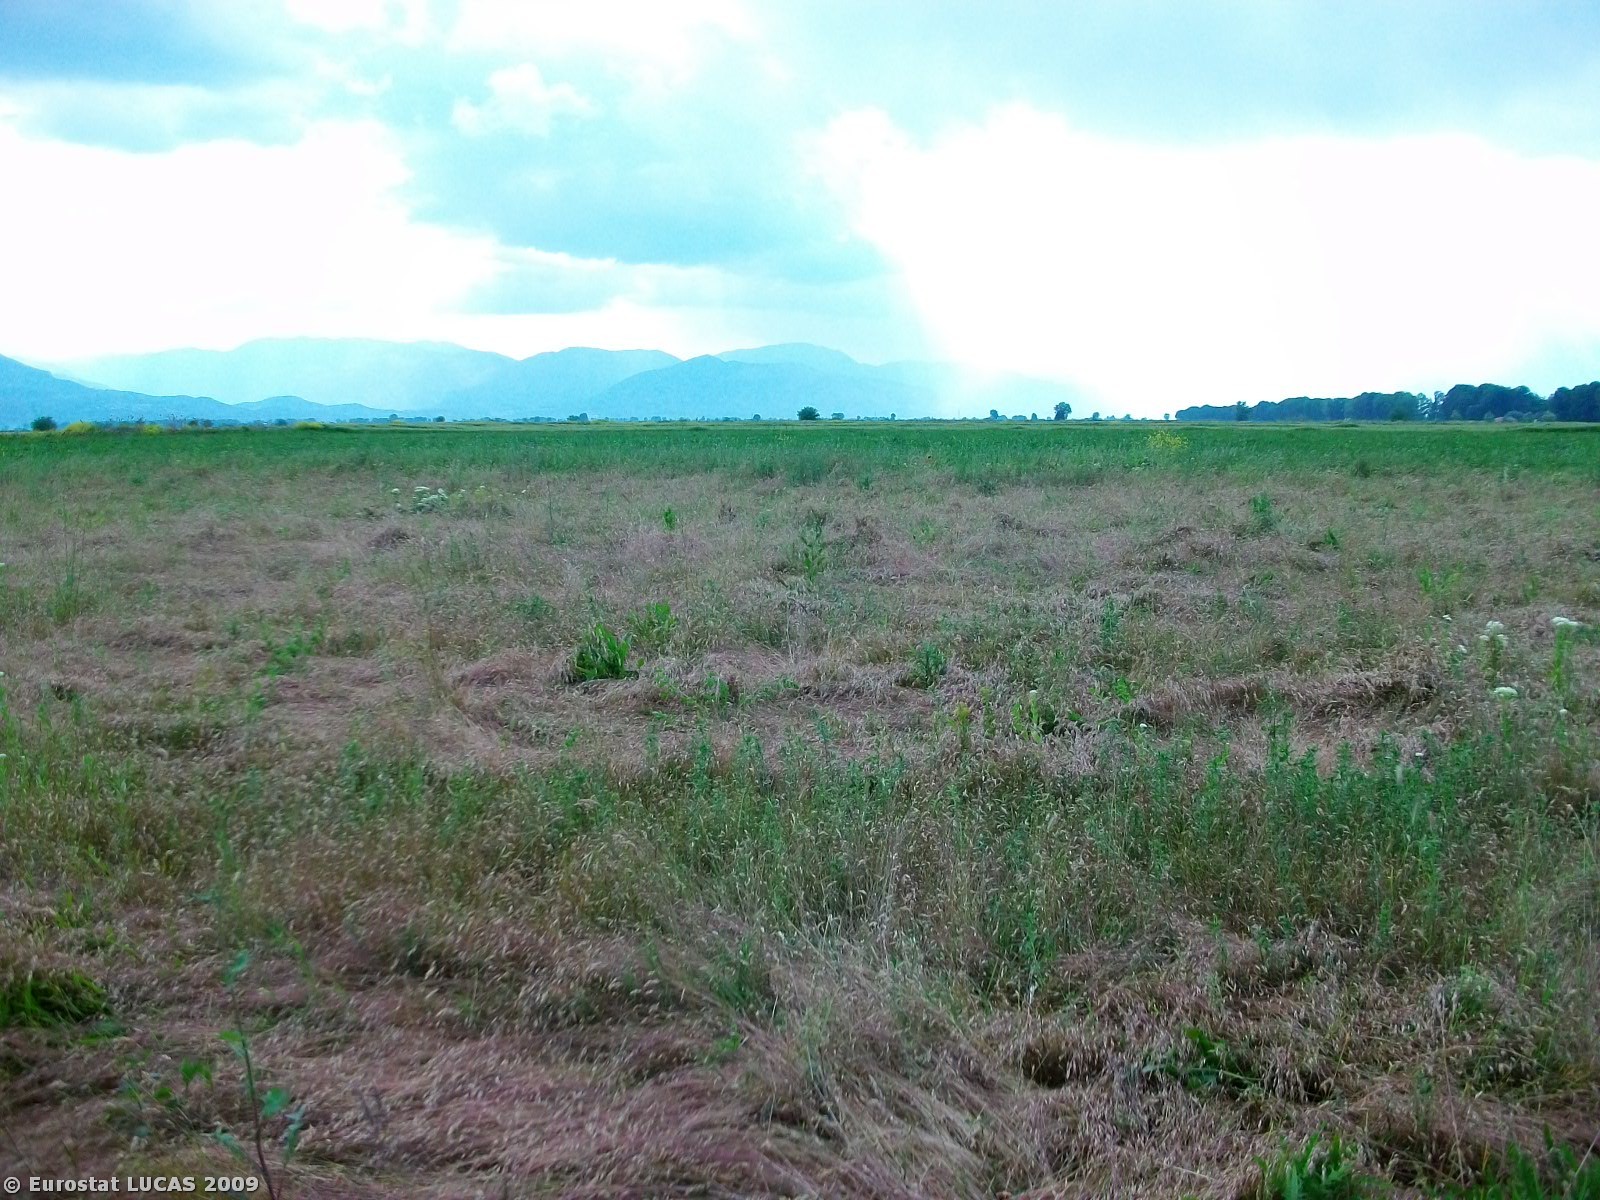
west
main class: Grassland
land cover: Spontaneously vegetated surfaces
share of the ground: > 75 %
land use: Fallow land
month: May
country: GR
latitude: 38.4328
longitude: 23.0973
